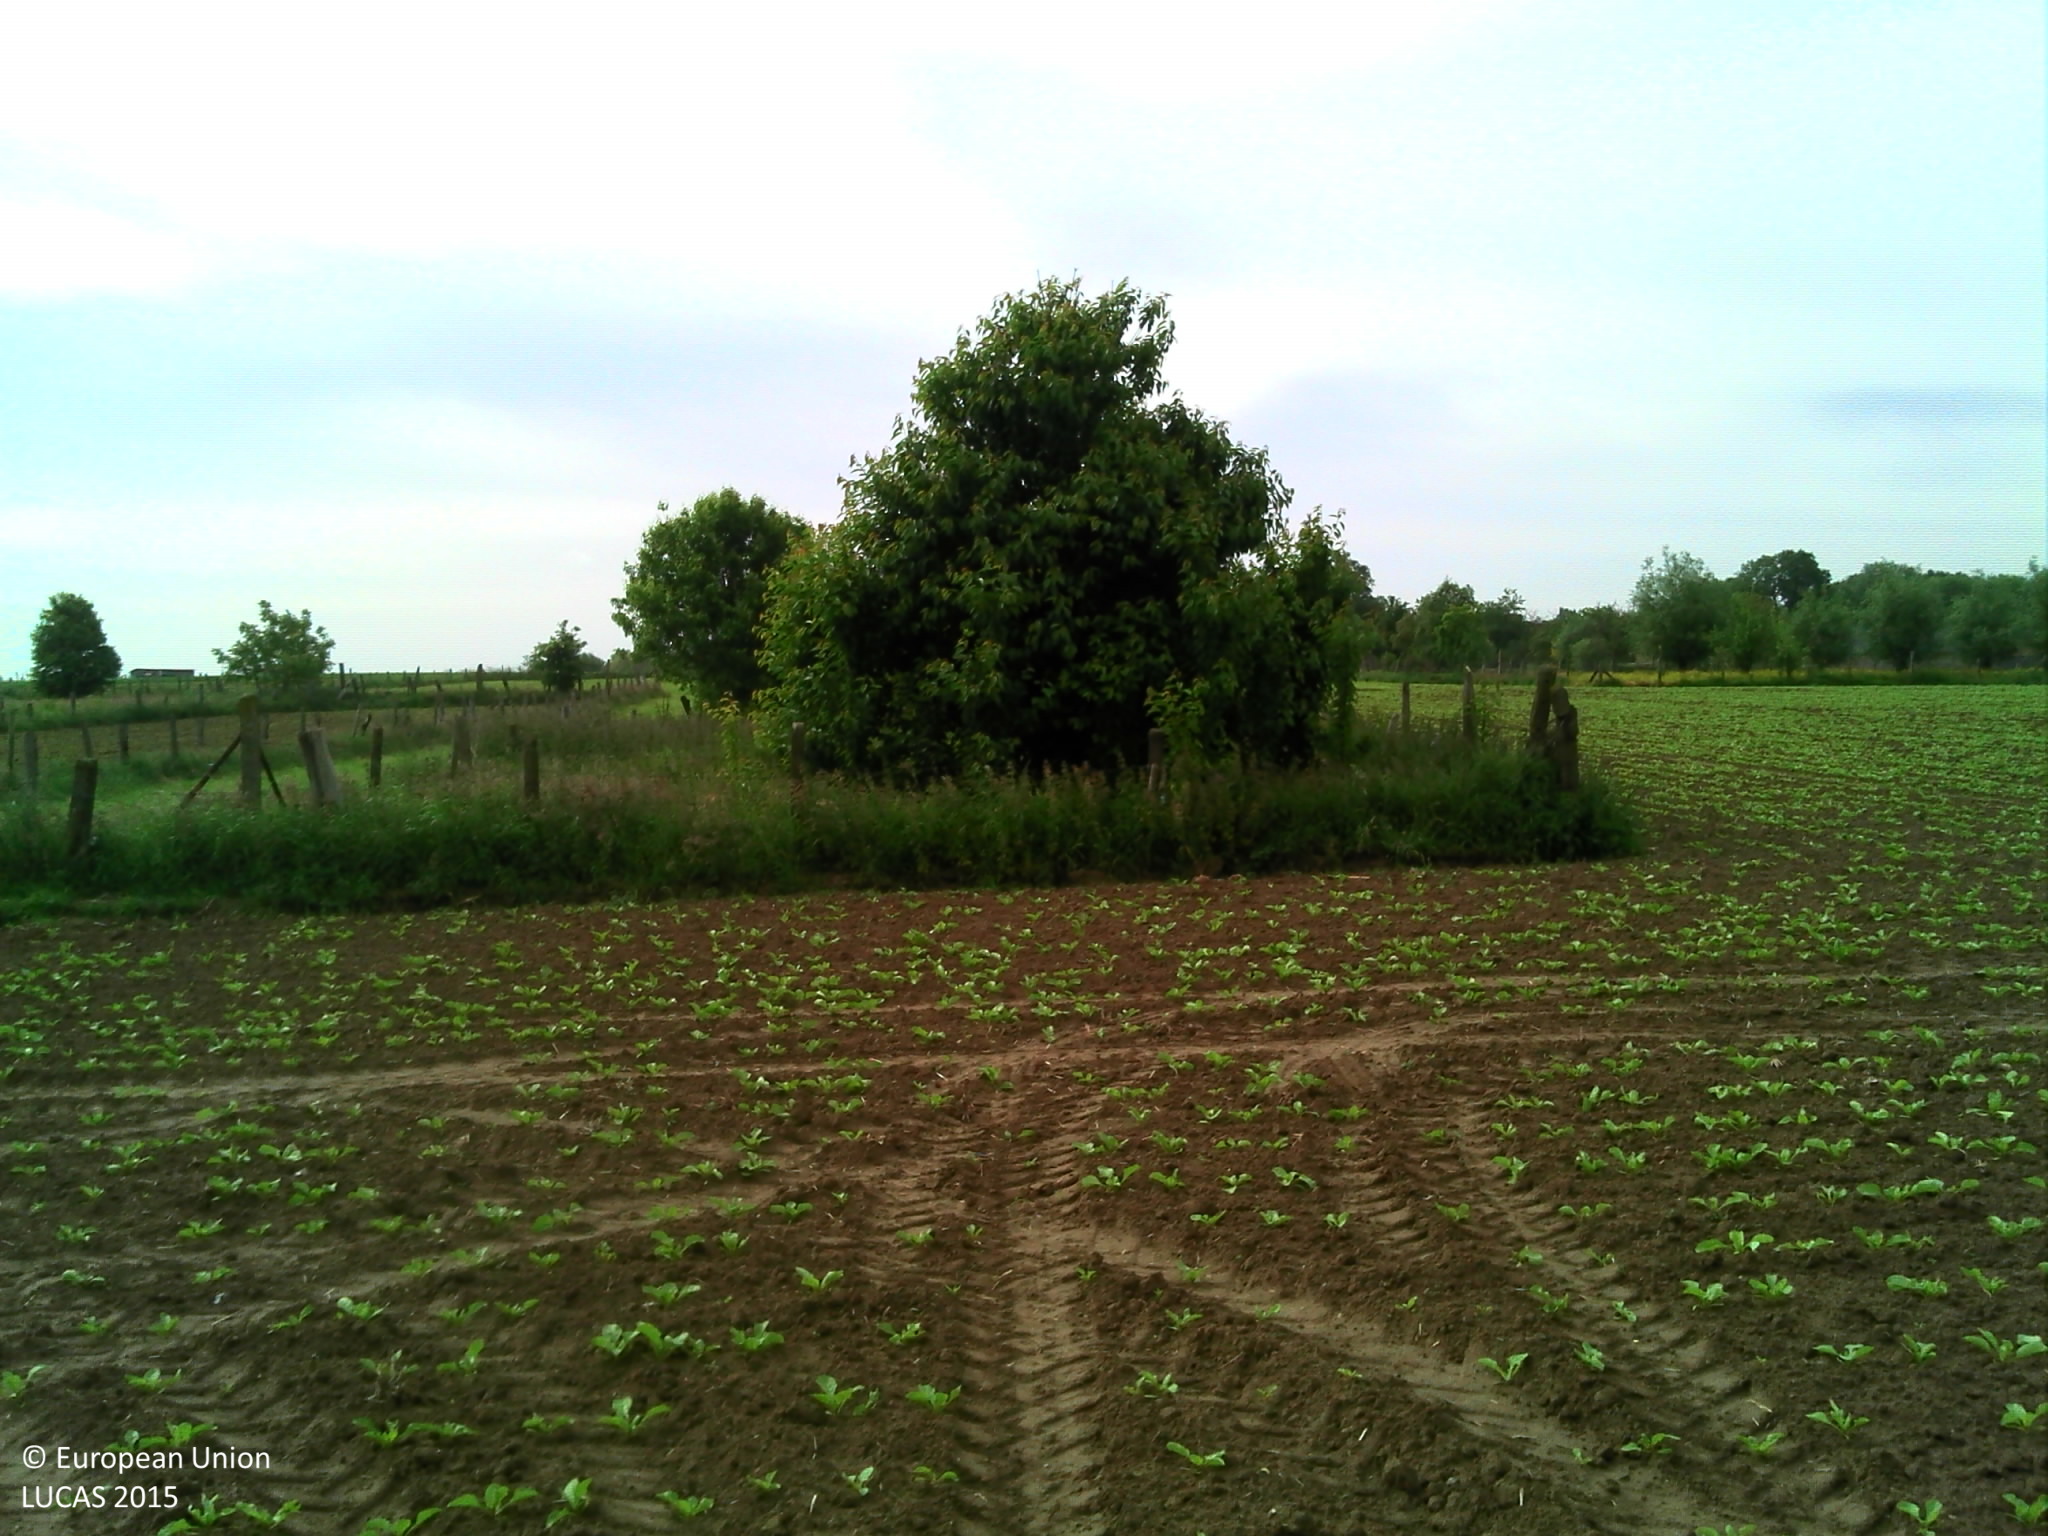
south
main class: Cropland
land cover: Sugar beet
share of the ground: 10 - 25 %
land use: Agriculture (excluding fallow land and kitchen gardens)
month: June
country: BE
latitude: 50.8264
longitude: 4.1314
